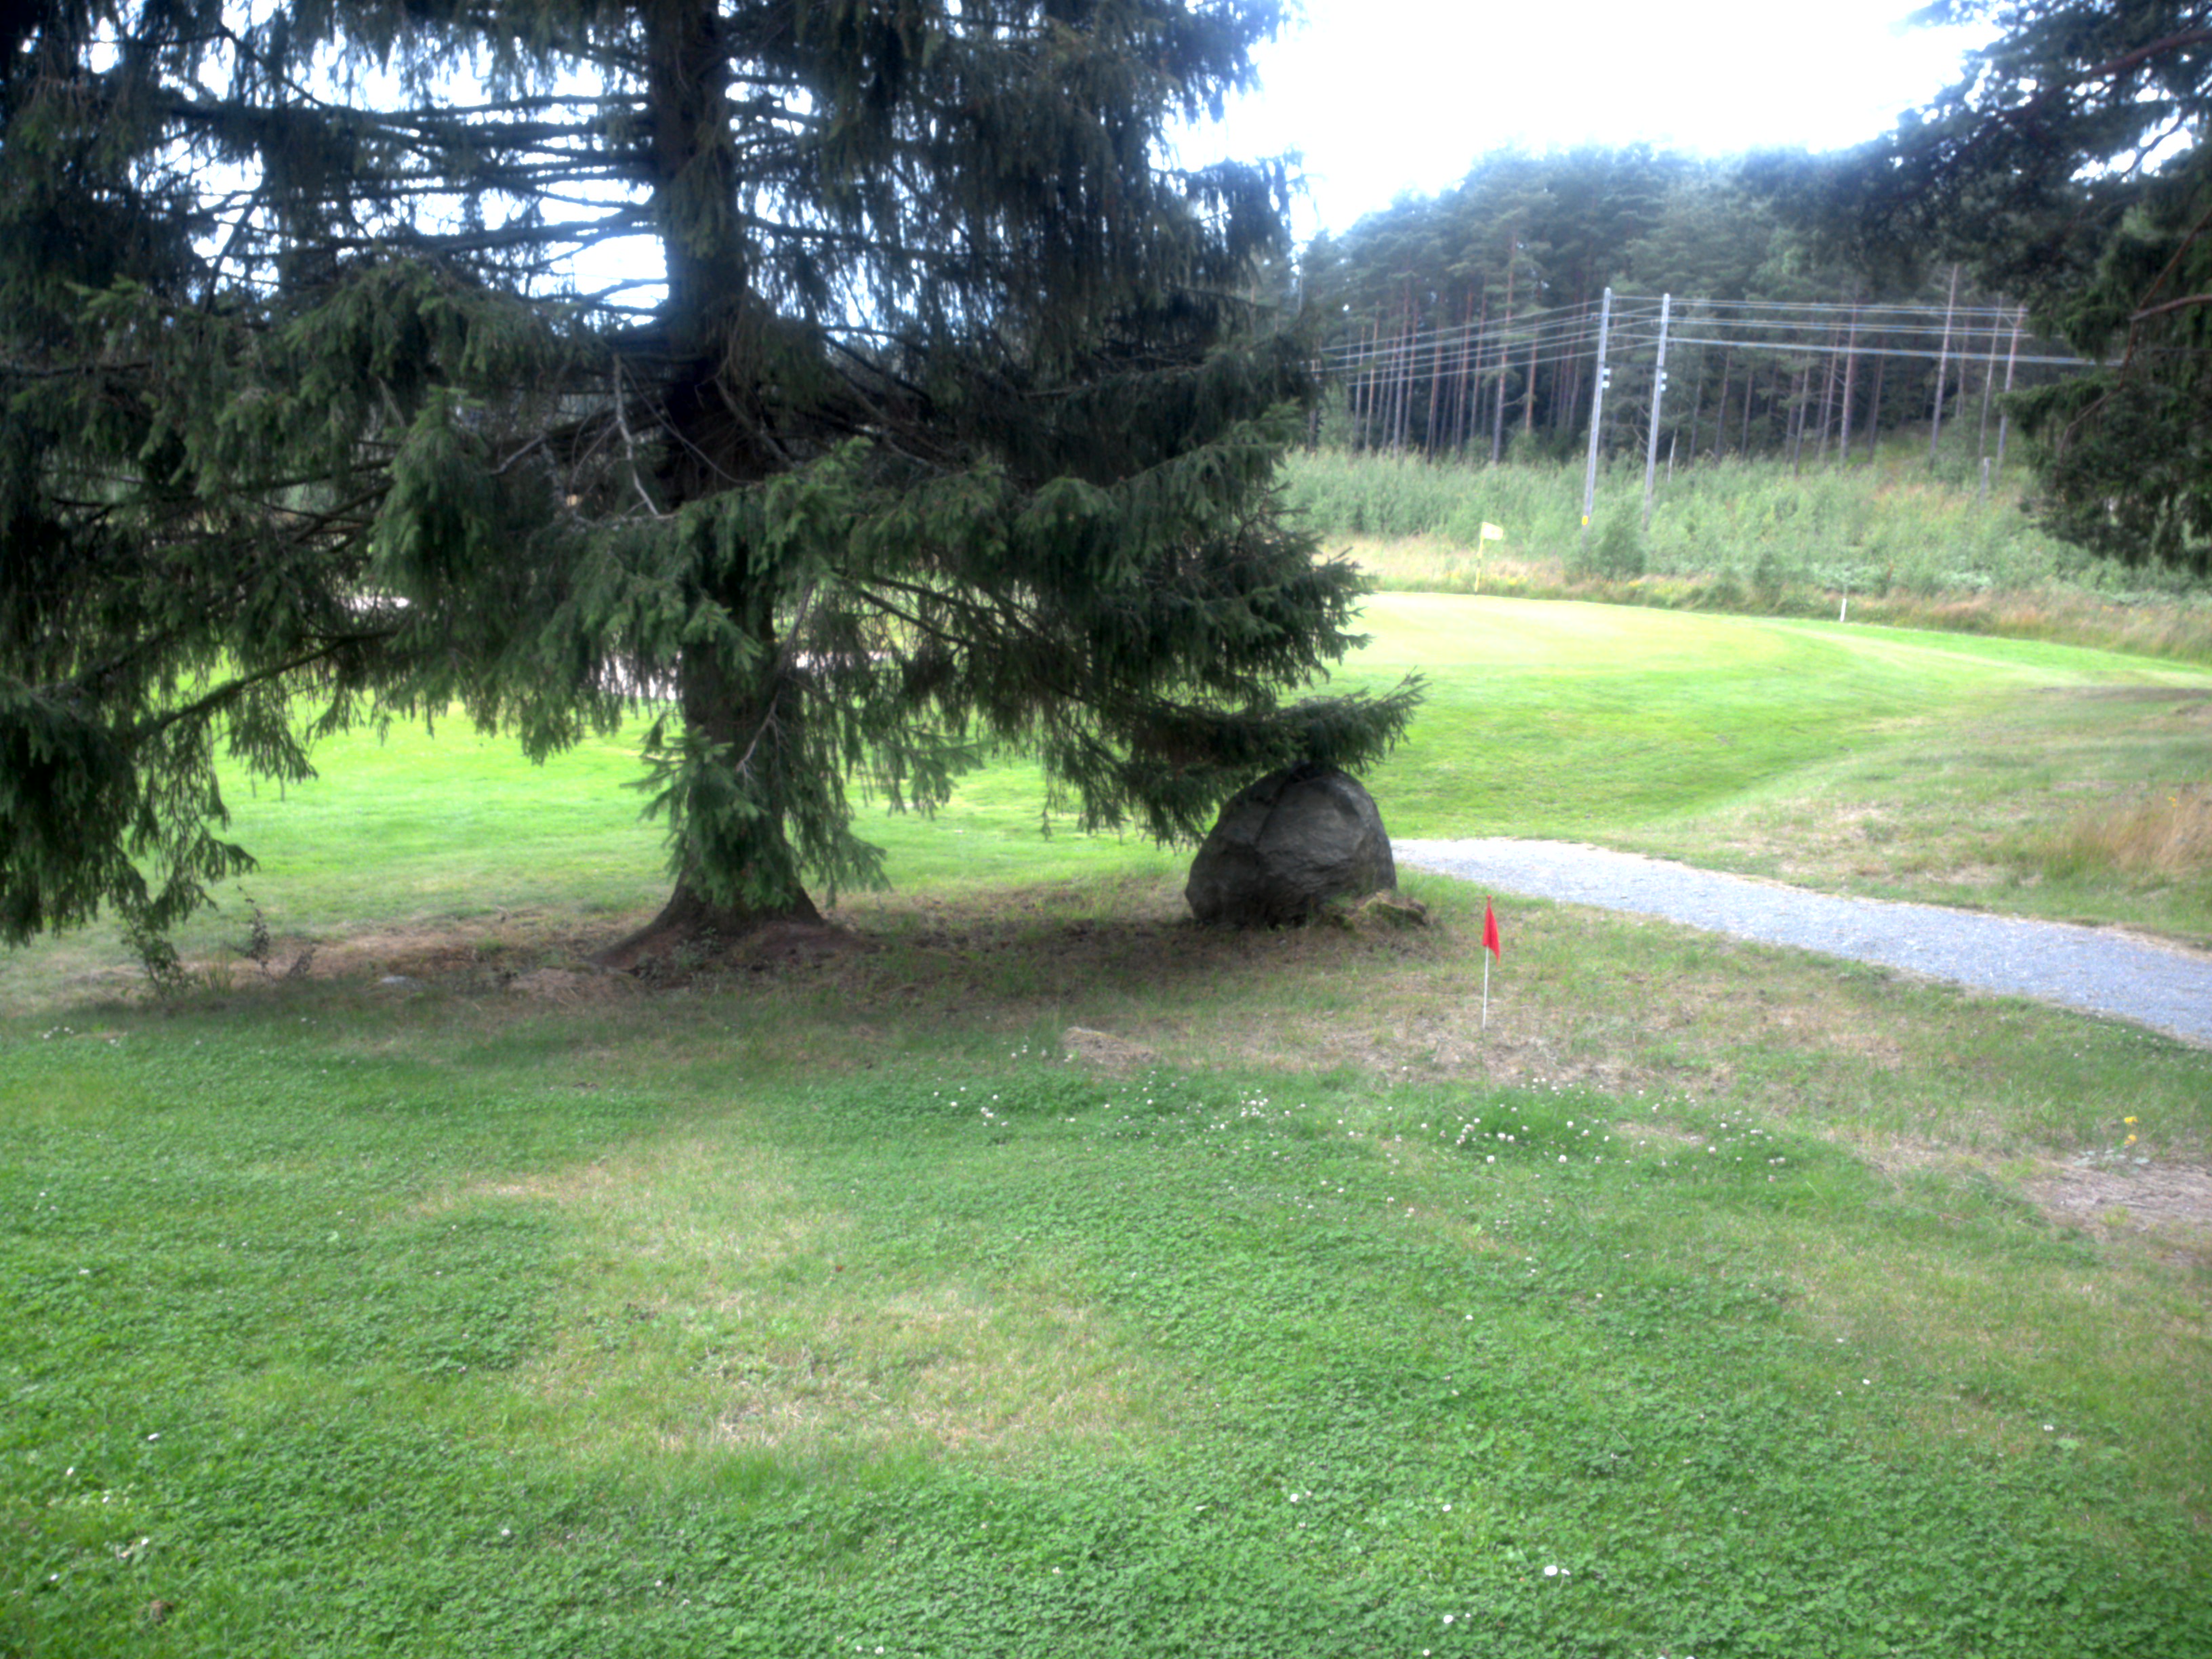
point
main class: Grassland
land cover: Grassland with sparse tree/shrub cover
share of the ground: > 75 %
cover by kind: herbaceous plants 95 %, broadleaved forest trees 5 %
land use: Sport
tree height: > 5 m
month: July
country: SE
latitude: 59.2523
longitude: 18.2242
